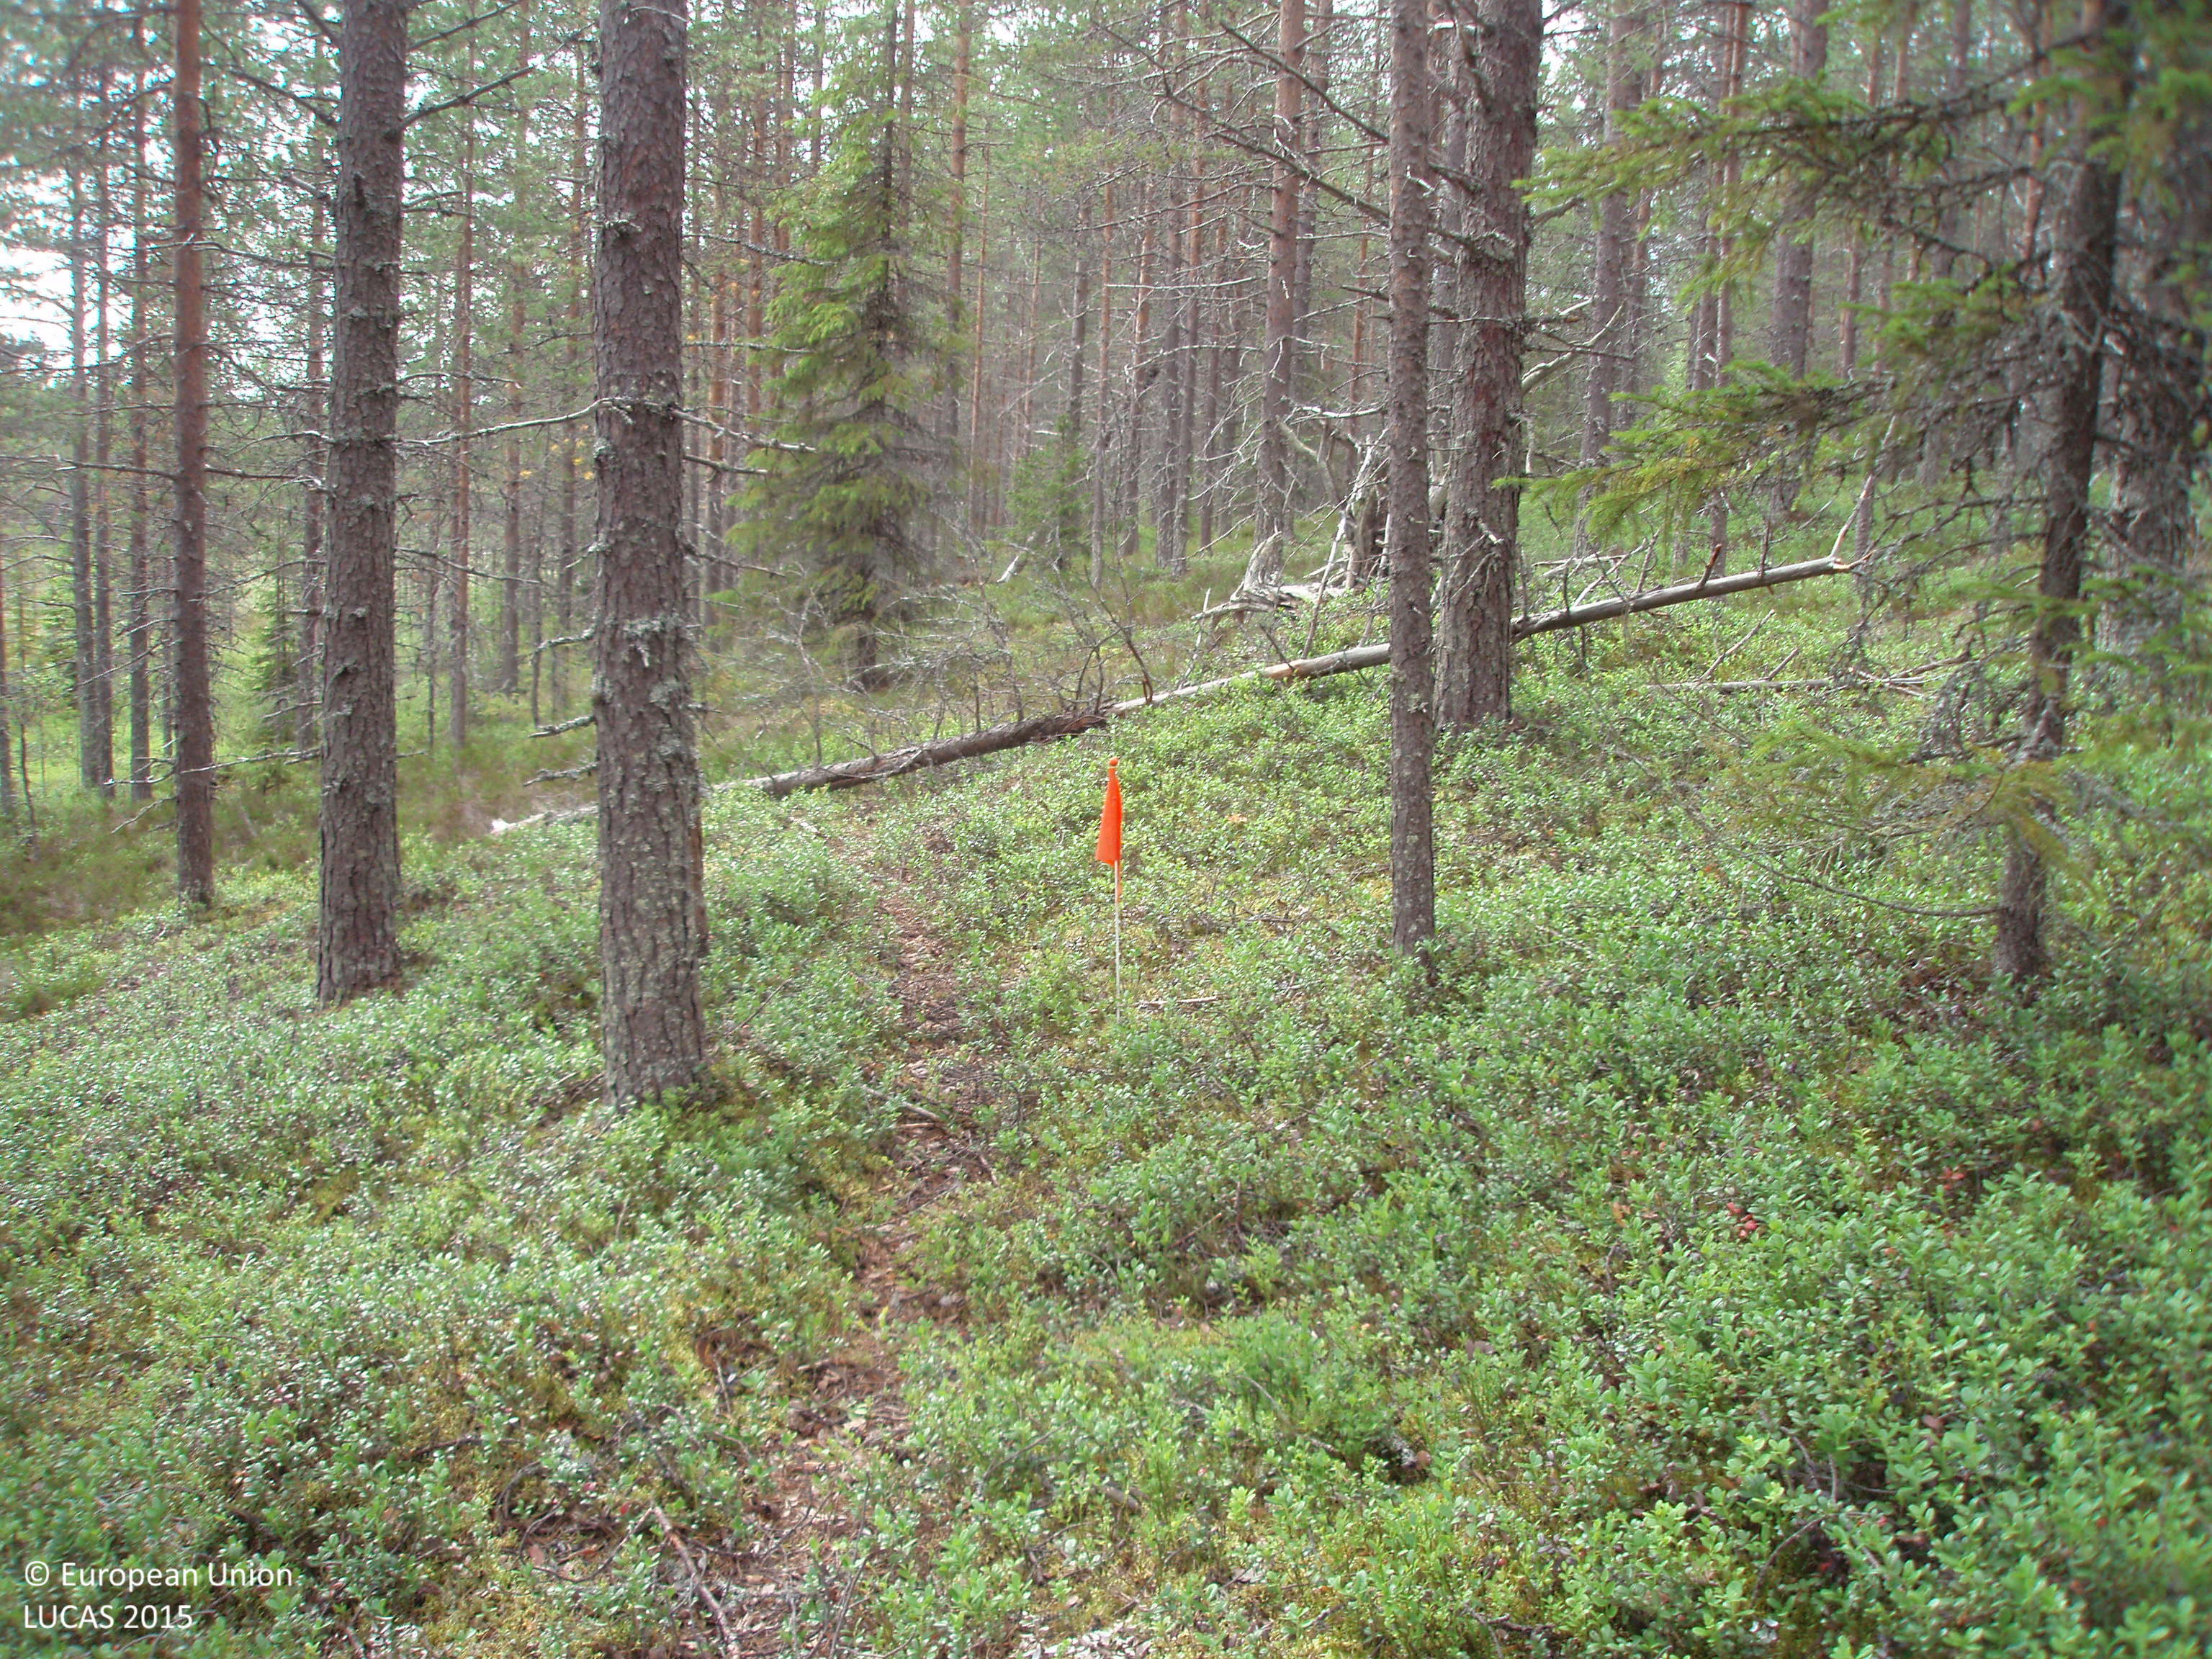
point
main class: Woodland
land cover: Pine dominated coniferous woodland
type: boreal forest
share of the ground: 50 - 75 %
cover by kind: coniferous forest trees 70 %, shrubs 30 %
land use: Forestry
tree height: > 5 m
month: July
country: FI
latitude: 65.6831
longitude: 27.6959
